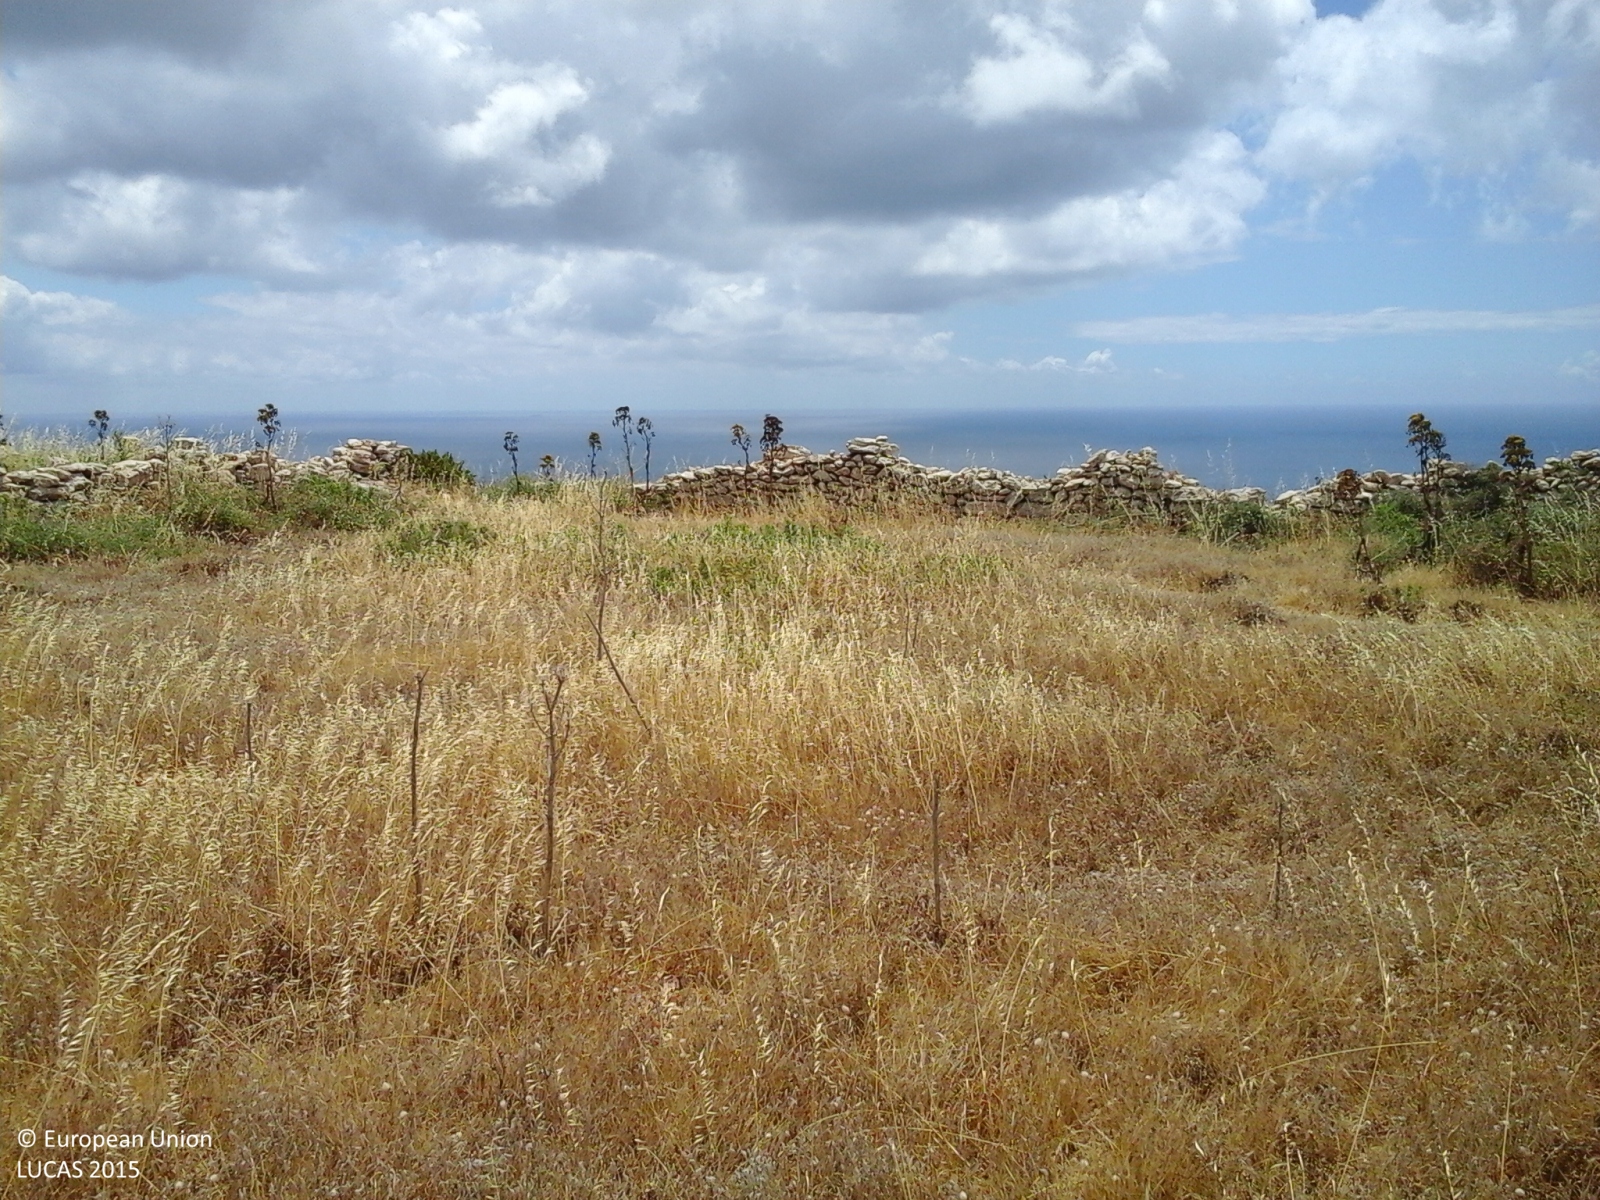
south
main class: Grassland
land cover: Grassland without tree/shrub cover
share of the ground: > 75 %
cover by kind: herbaceous plants 95 %
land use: Abandoned areas
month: May
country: MT
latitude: 36.0360
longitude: 14.1902
